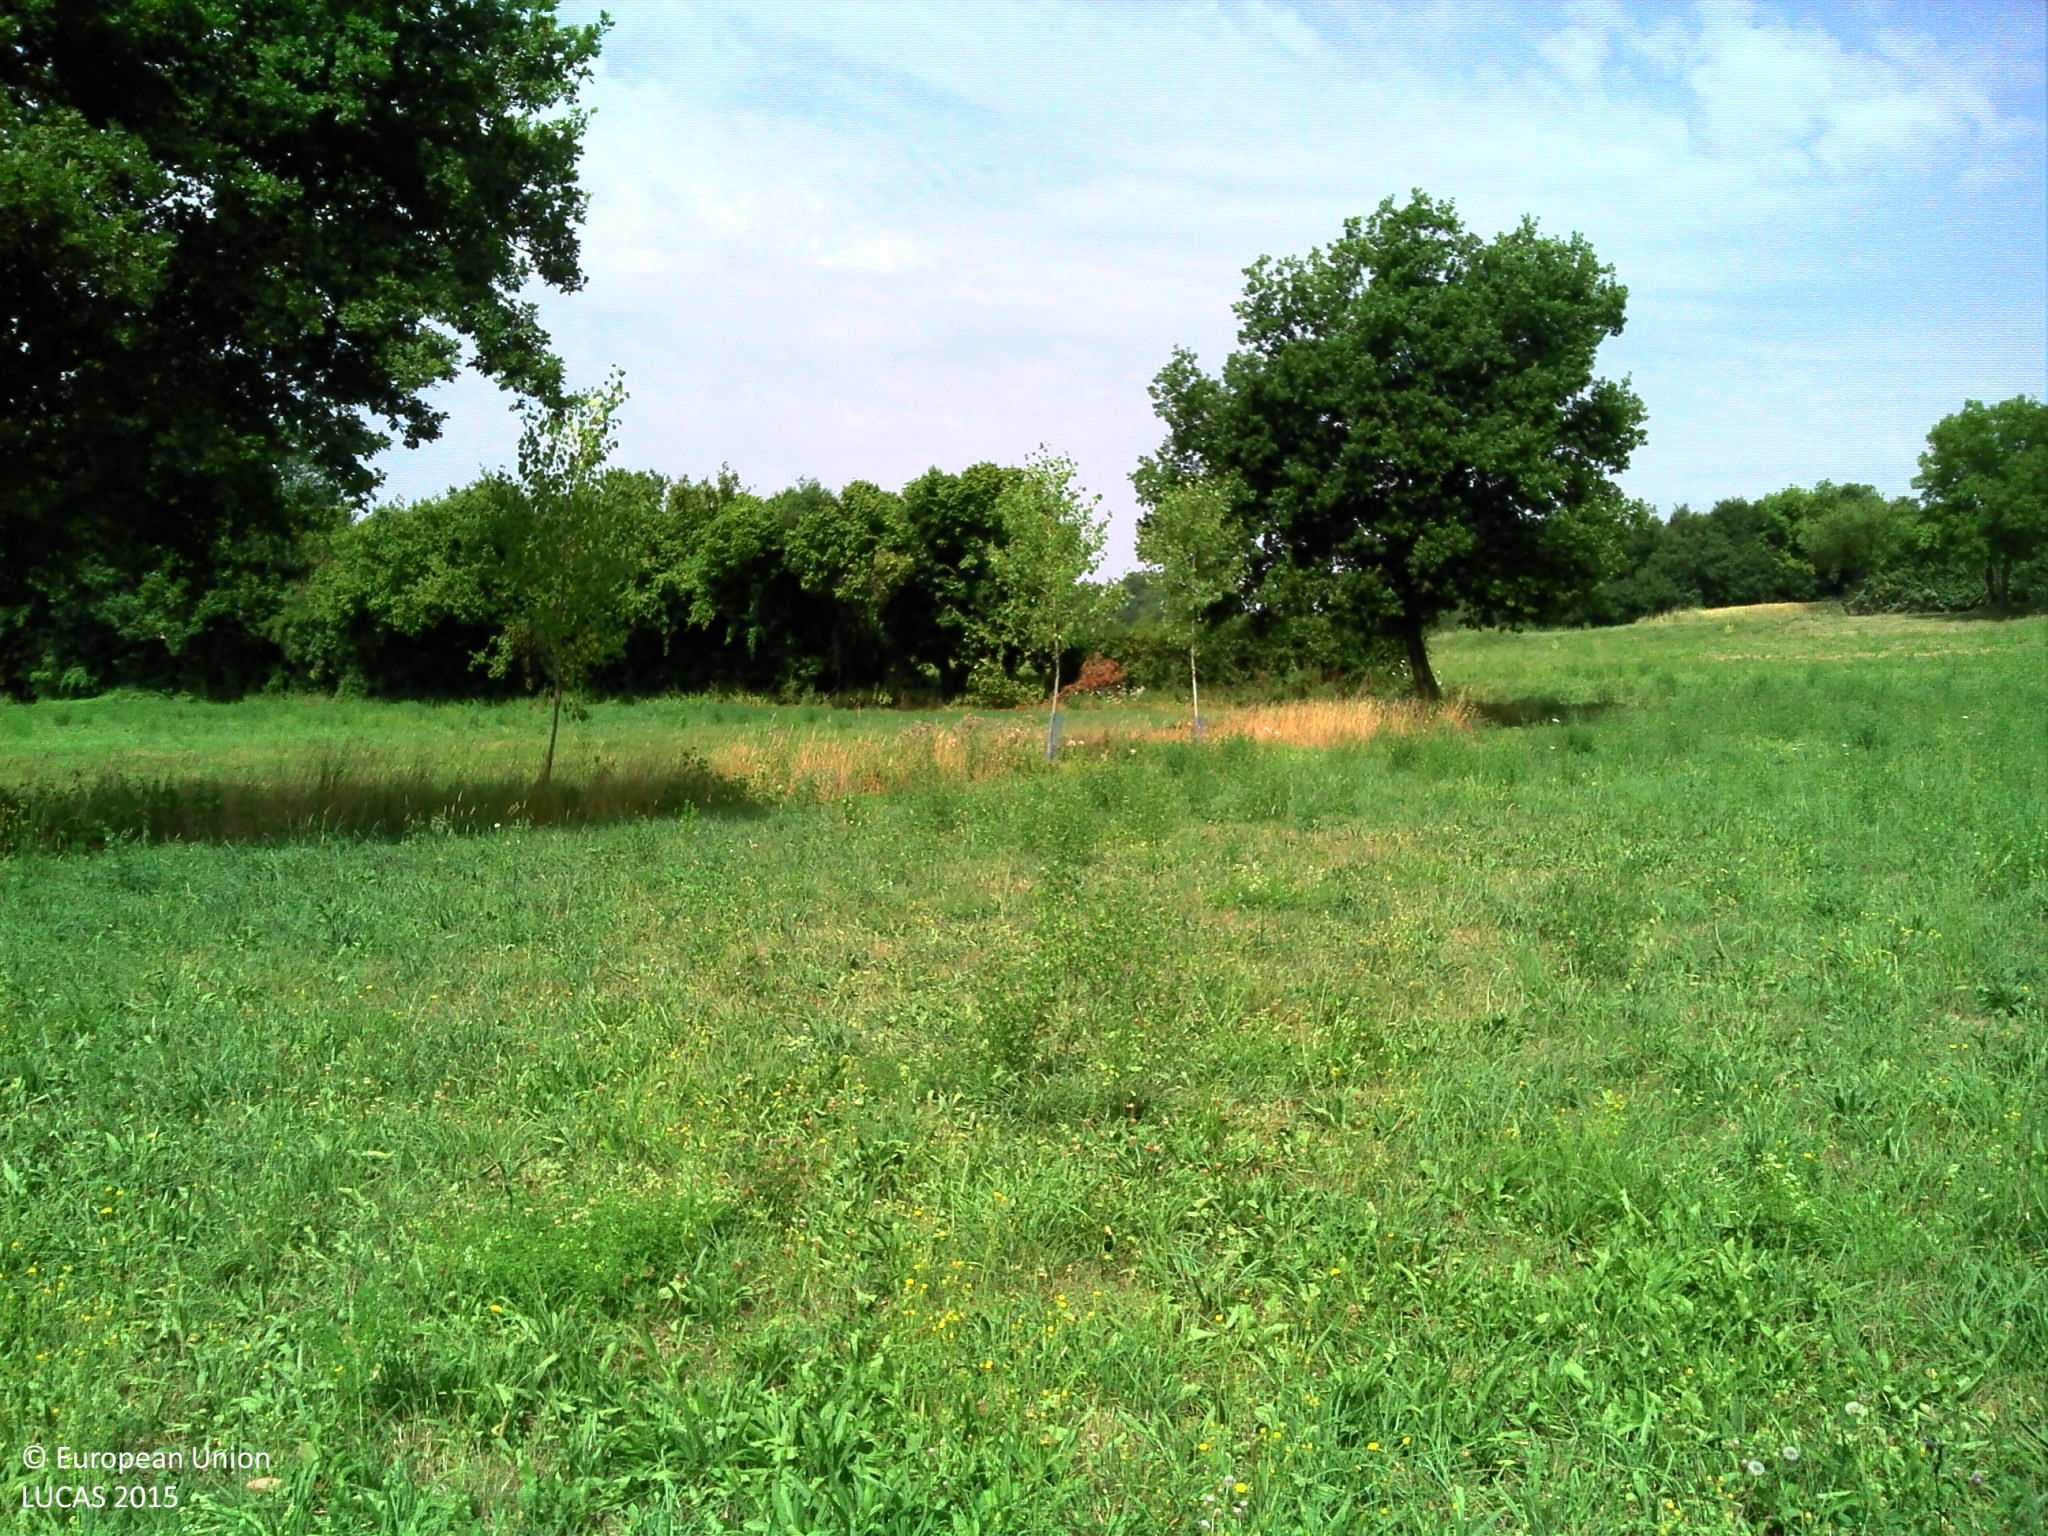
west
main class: Grassland
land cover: Grassland with sparse tree/shrub cover
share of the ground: > 75 %
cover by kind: herbaceous plants 95 %, broadleaved forest trees 5 %
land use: Agriculture (excluding fallow land and kitchen gardens)
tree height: > 5 m
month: July
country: FR
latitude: 45.7298
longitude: 5.4167
